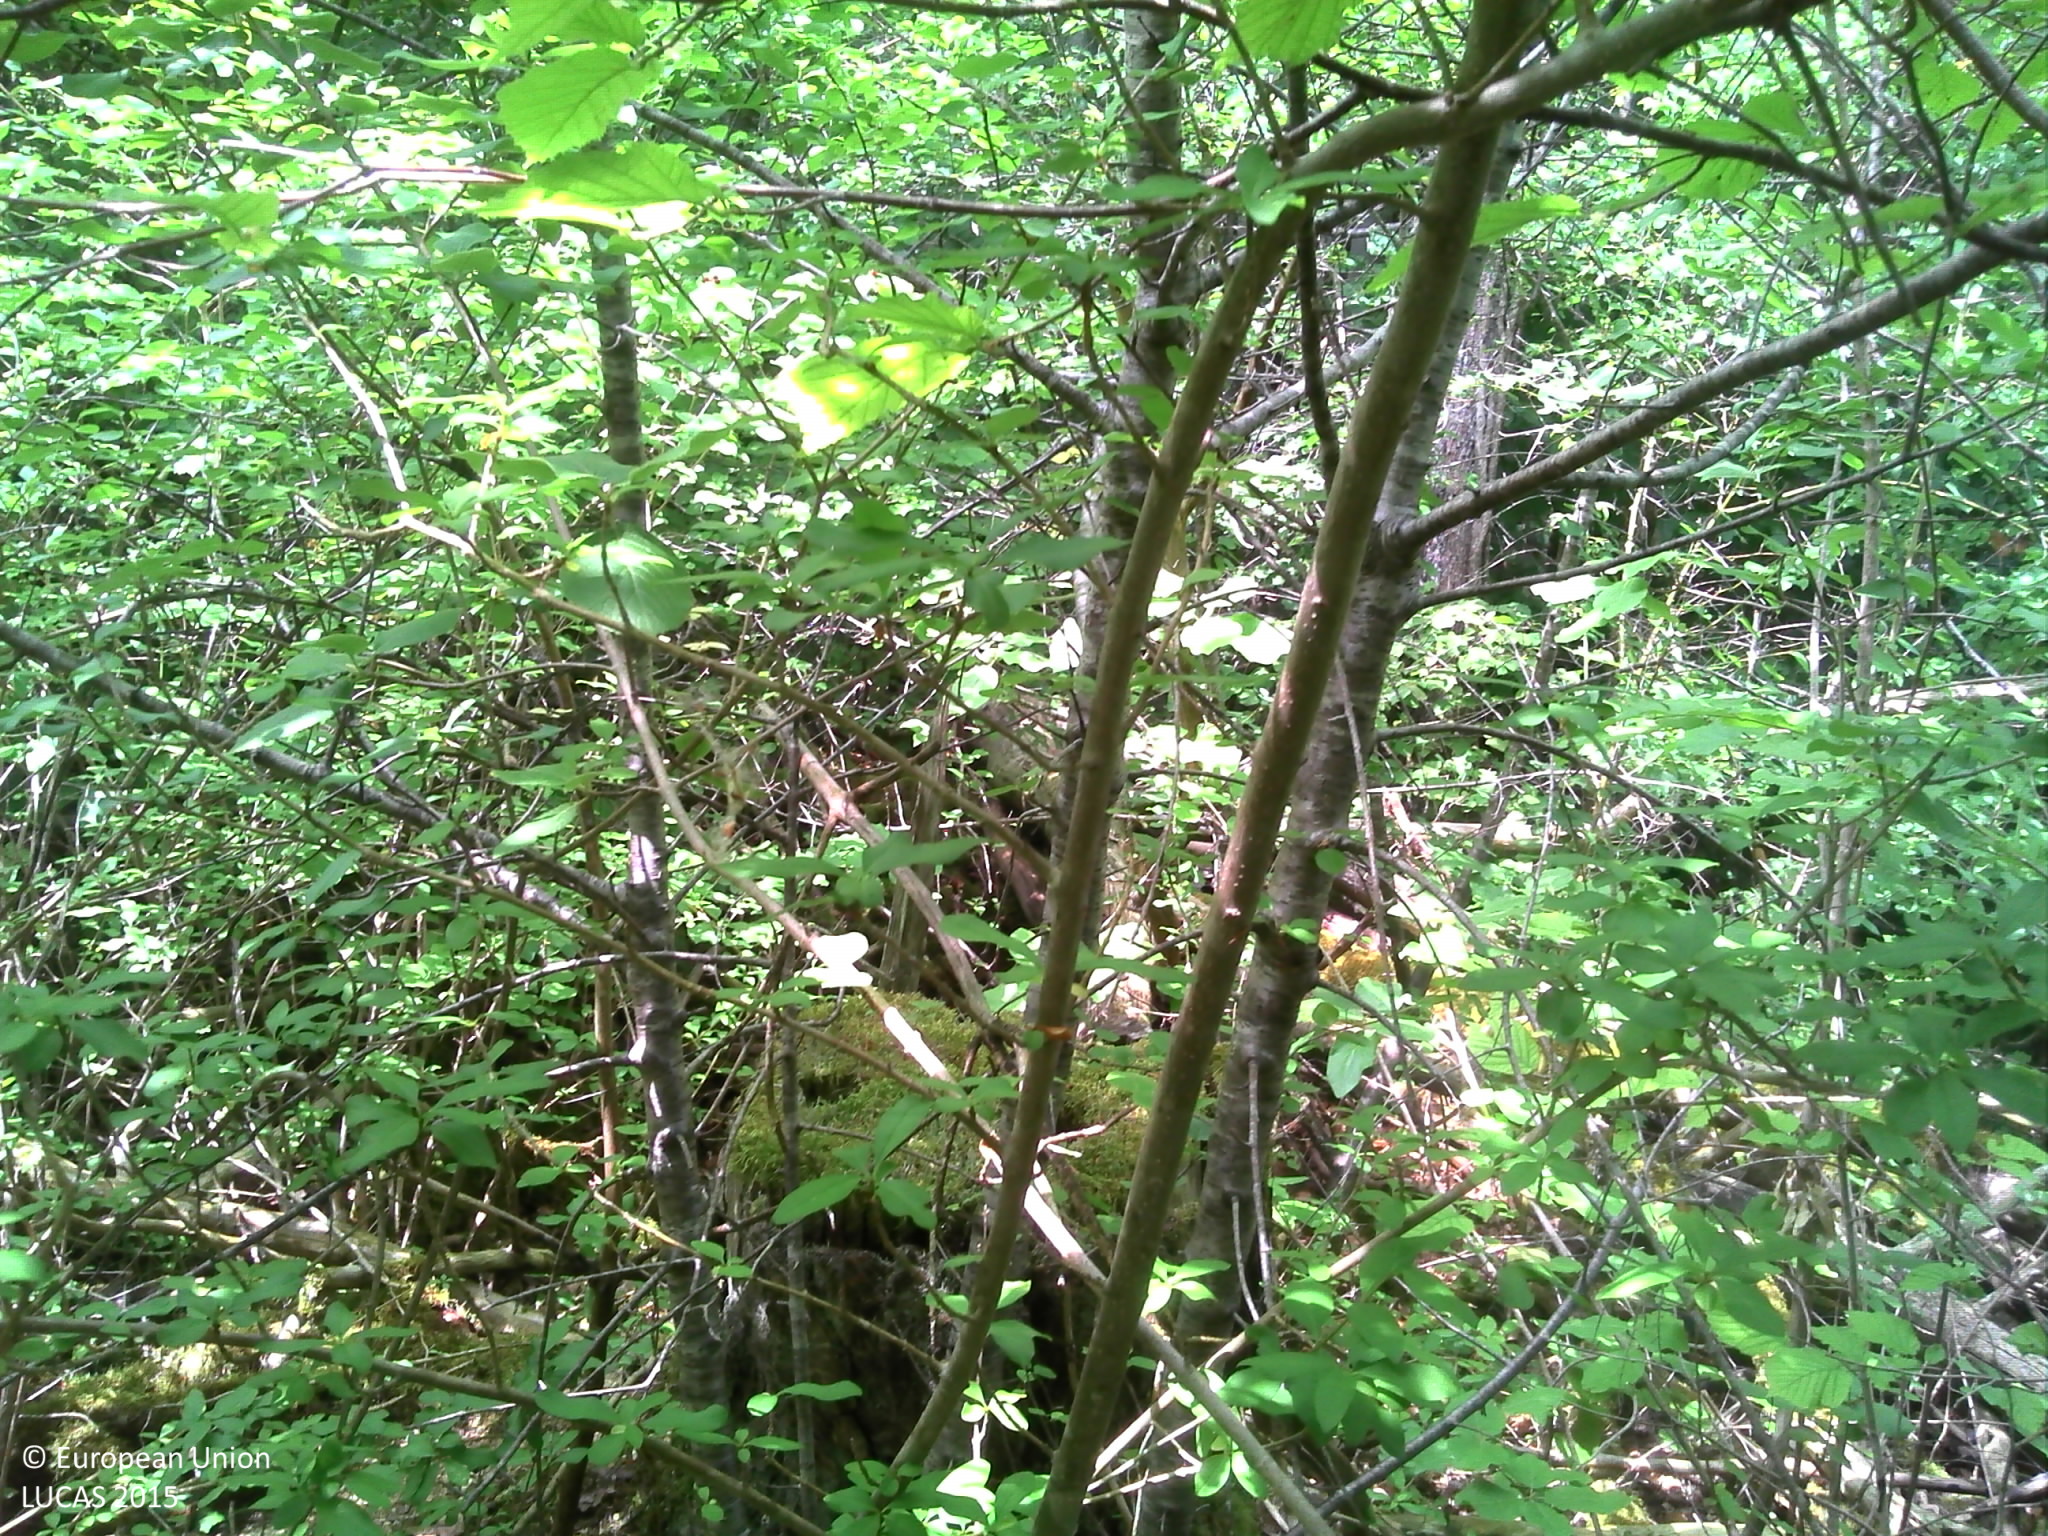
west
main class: Woodland
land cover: Broadleaved woodland
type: boreal forest
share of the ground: > 75 %
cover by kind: broadleaved forest trees 90 %, herbaceous plants 5 %, lichens and mosses 5 %
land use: Forestry
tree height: > 5 m
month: July
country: FR
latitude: 47.5963
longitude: 3.4658
